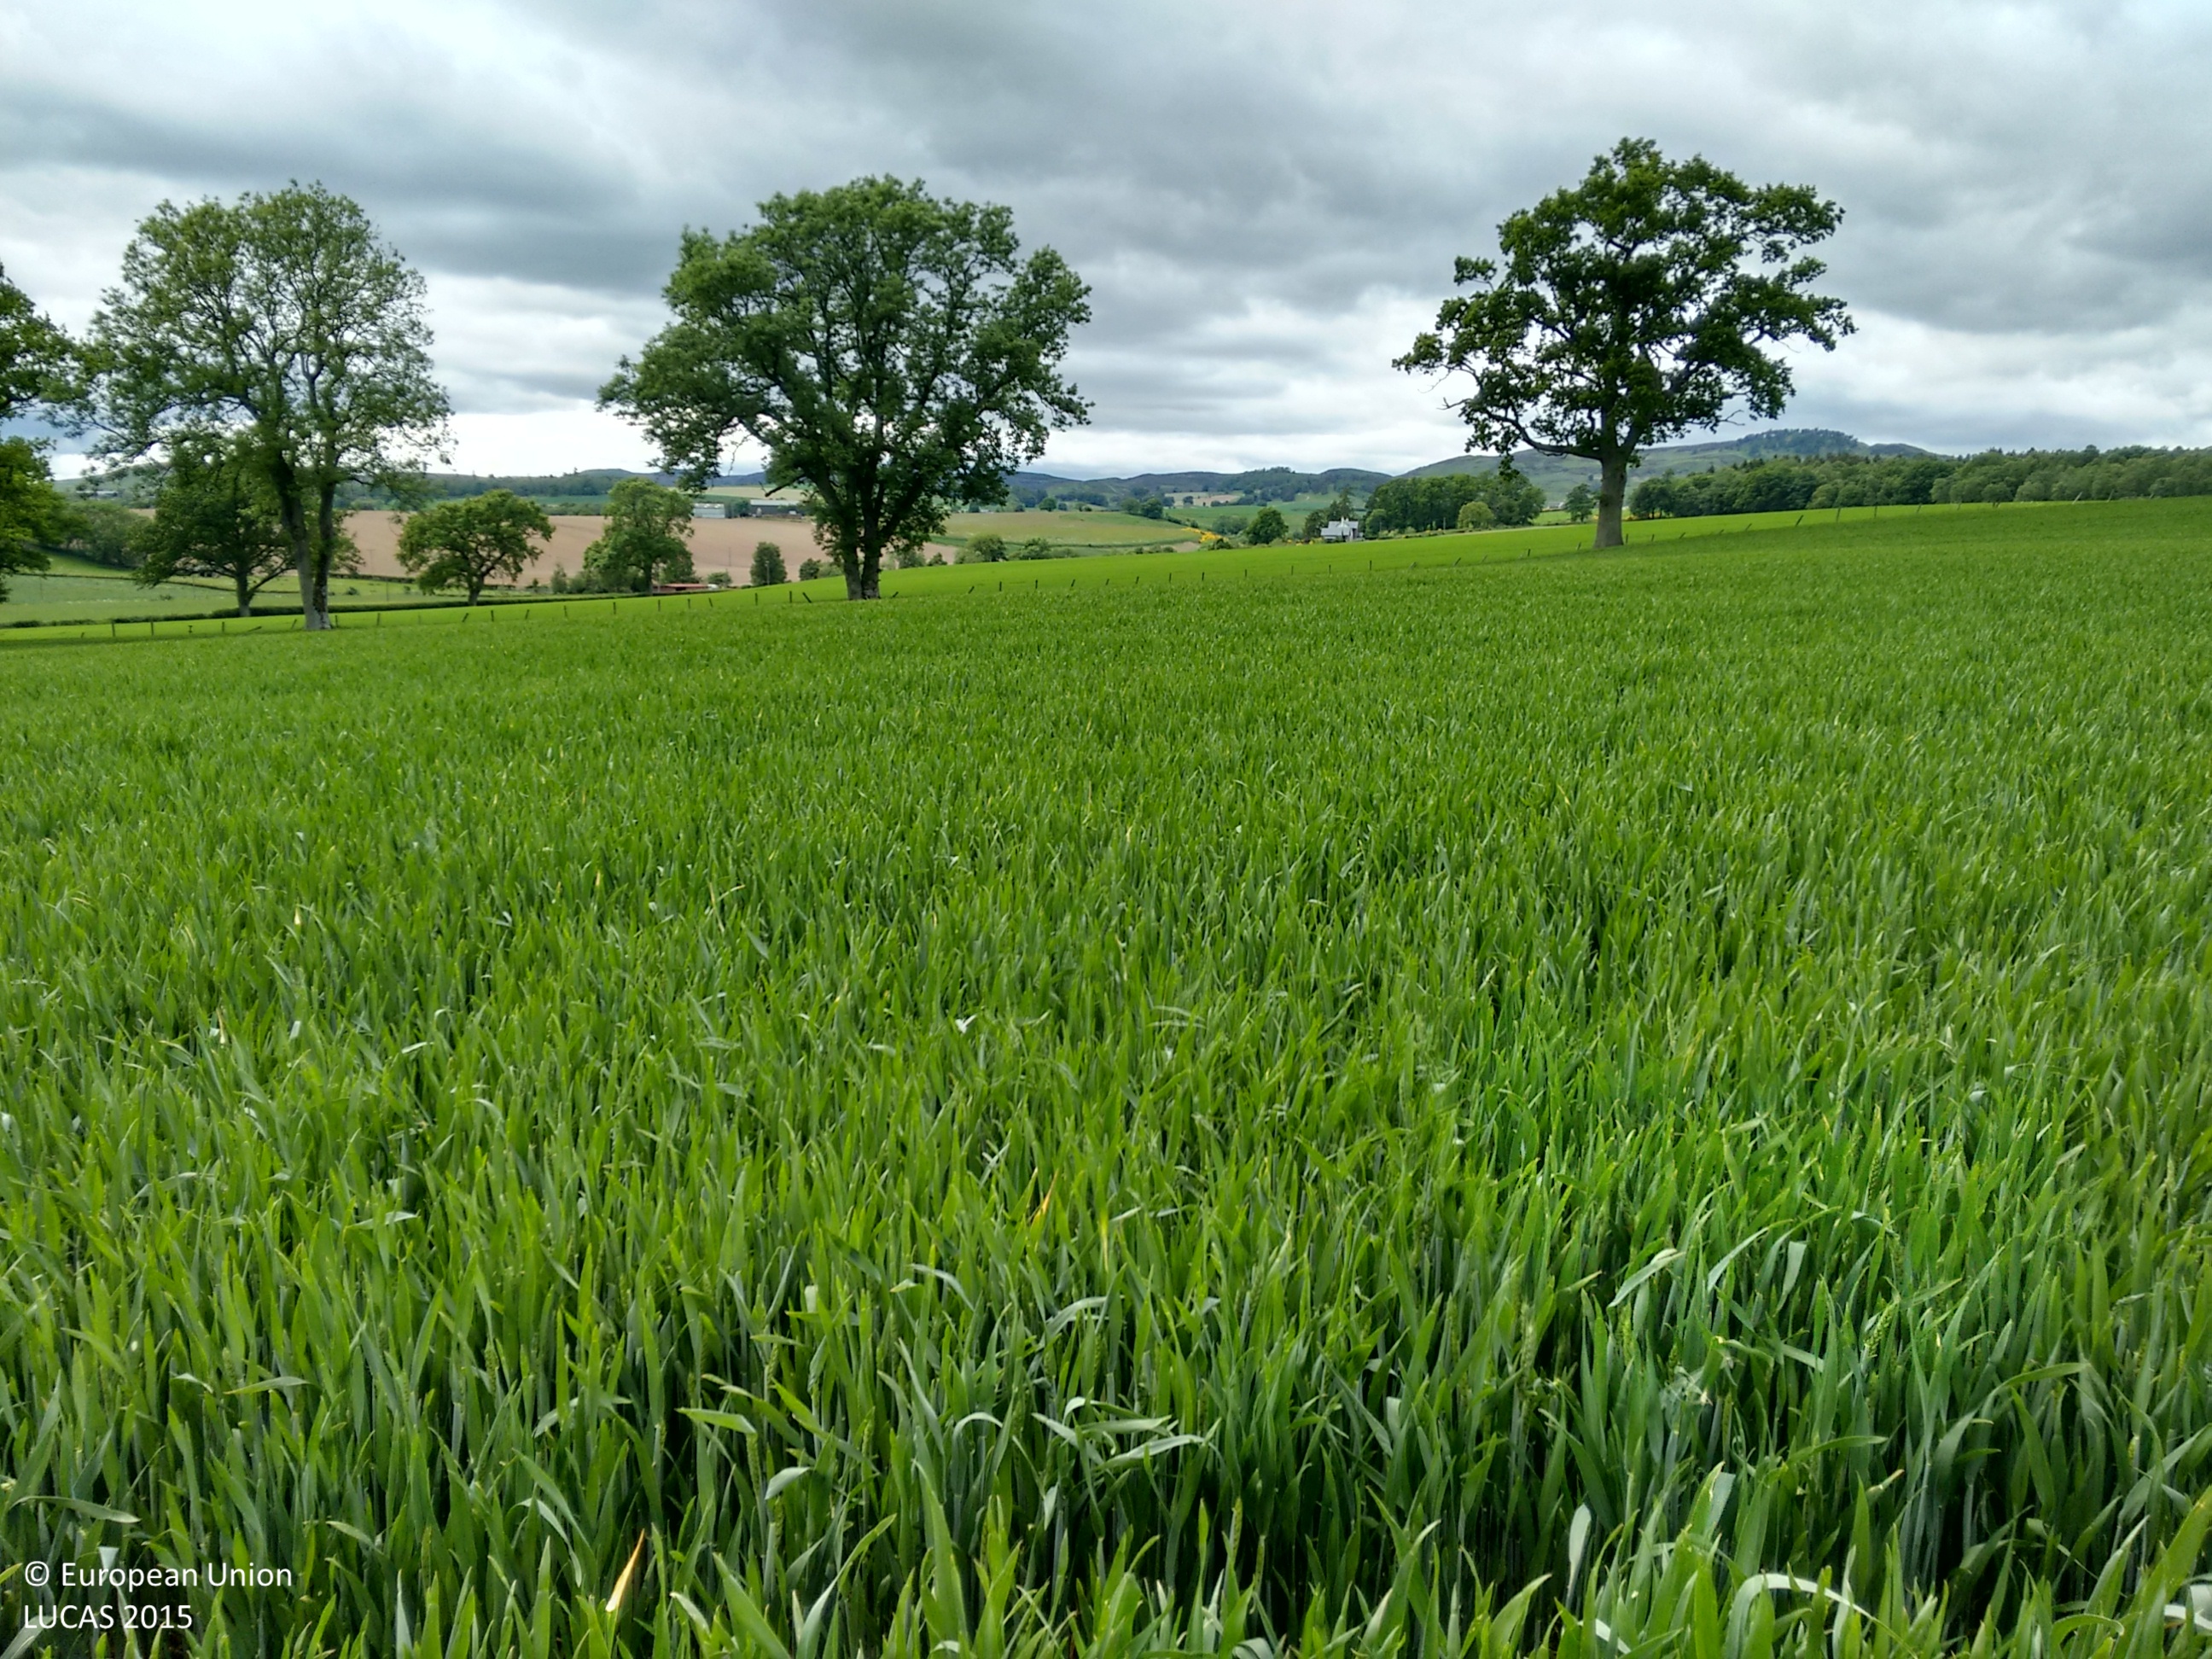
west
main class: Cropland
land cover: Common wheat
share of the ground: > 75 %
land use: Agriculture (excluding fallow land and kitchen gardens)
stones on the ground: 25 - 50 %
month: June
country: GB
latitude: 56.5061
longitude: -3.5455
